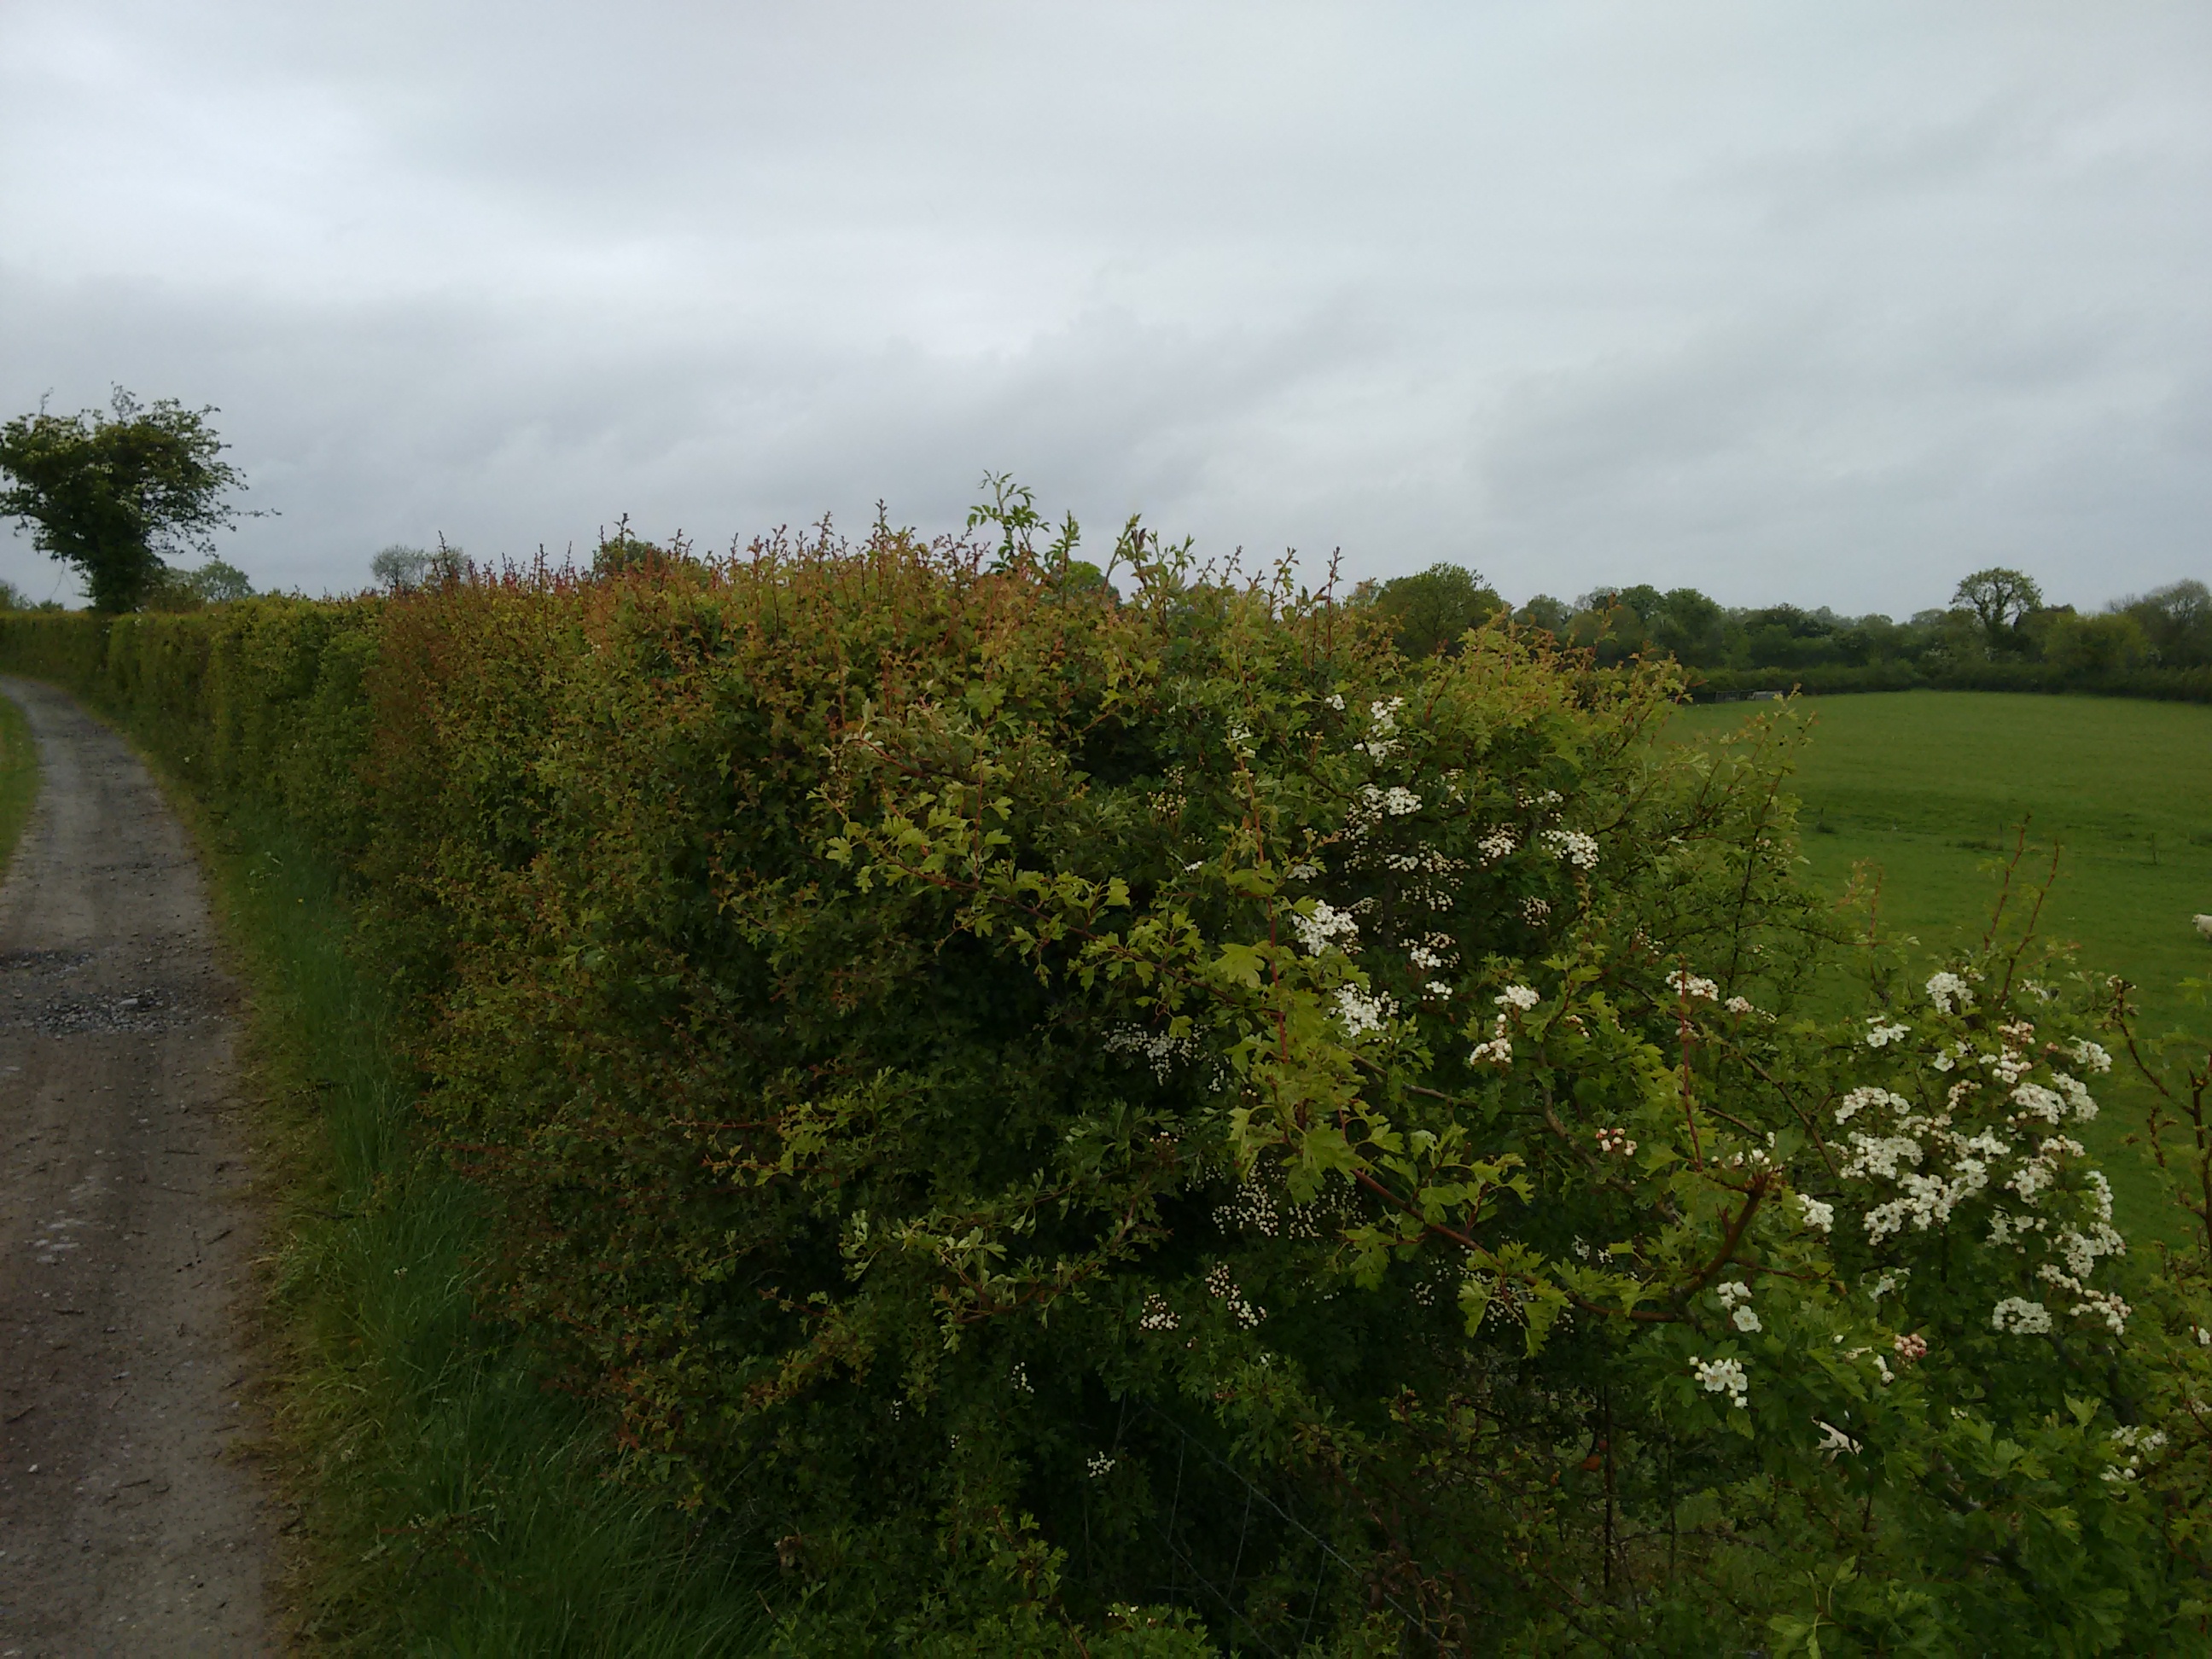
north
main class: Grassland
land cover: Grassland without tree/shrub cover
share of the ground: > 75 %
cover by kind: herbaceous plants 95 %, unconsolidated bare surface 5 %
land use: Agriculture (excluding fallow land and kitchen gardens)
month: May
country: IE
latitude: 53.4616
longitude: -6.9649
